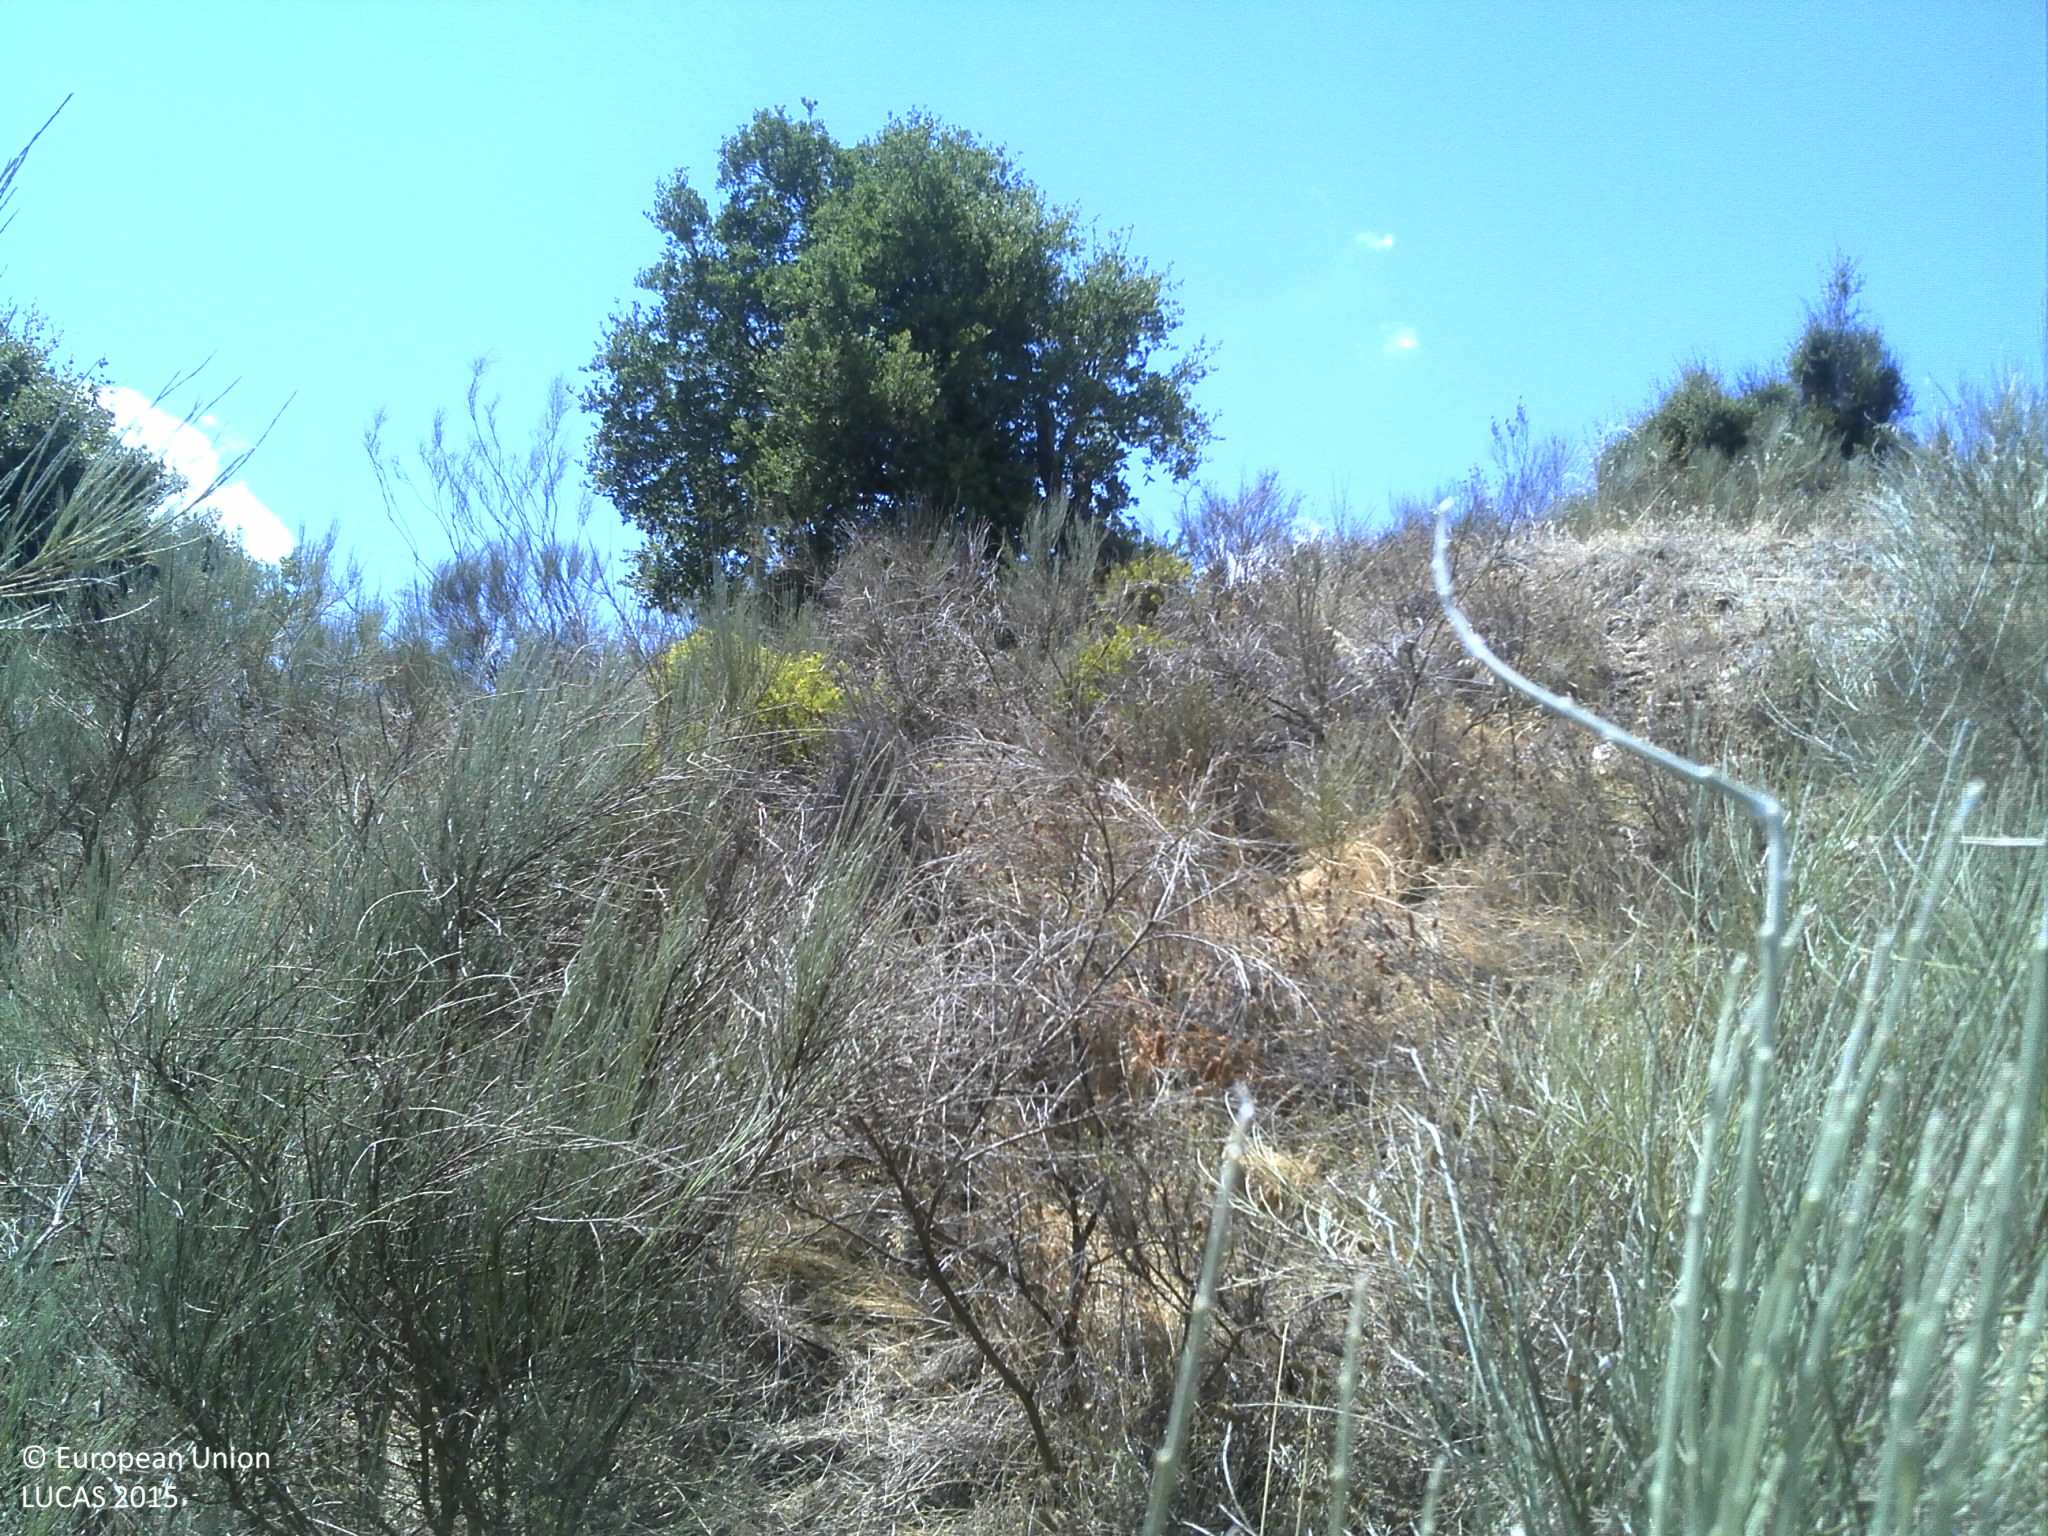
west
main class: Shrubland
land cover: Shrubland with sparse tree cover
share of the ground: > 75 %
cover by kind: shrubs 95 %, broadleaved forest trees 5 %
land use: Semi-natural and natural areas not in use
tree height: < 5 m
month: July
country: PT
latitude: 41.3517
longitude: -7.0008
